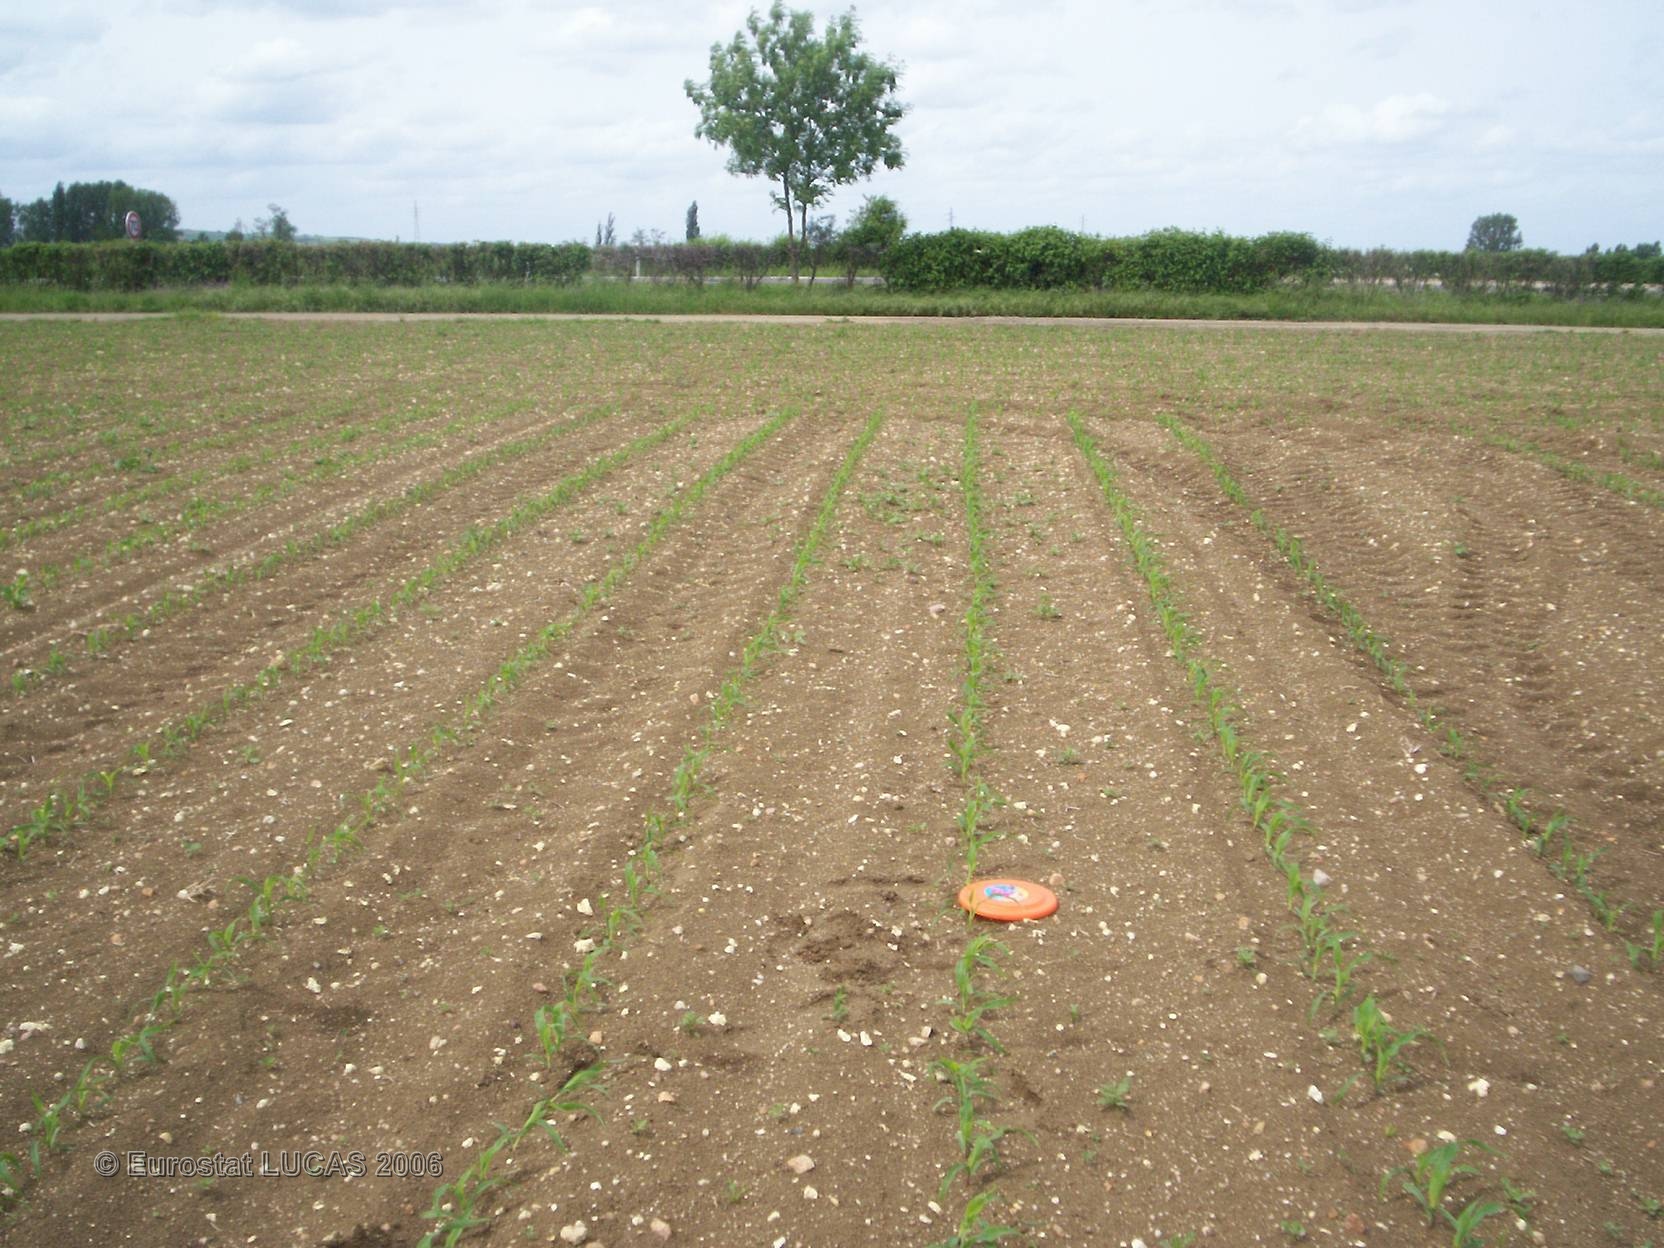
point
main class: Cropland
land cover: Maize
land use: Agriculture (excluding fallow land and kitchen gardens)
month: May
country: FR
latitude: 46.1007
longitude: 3.2337
